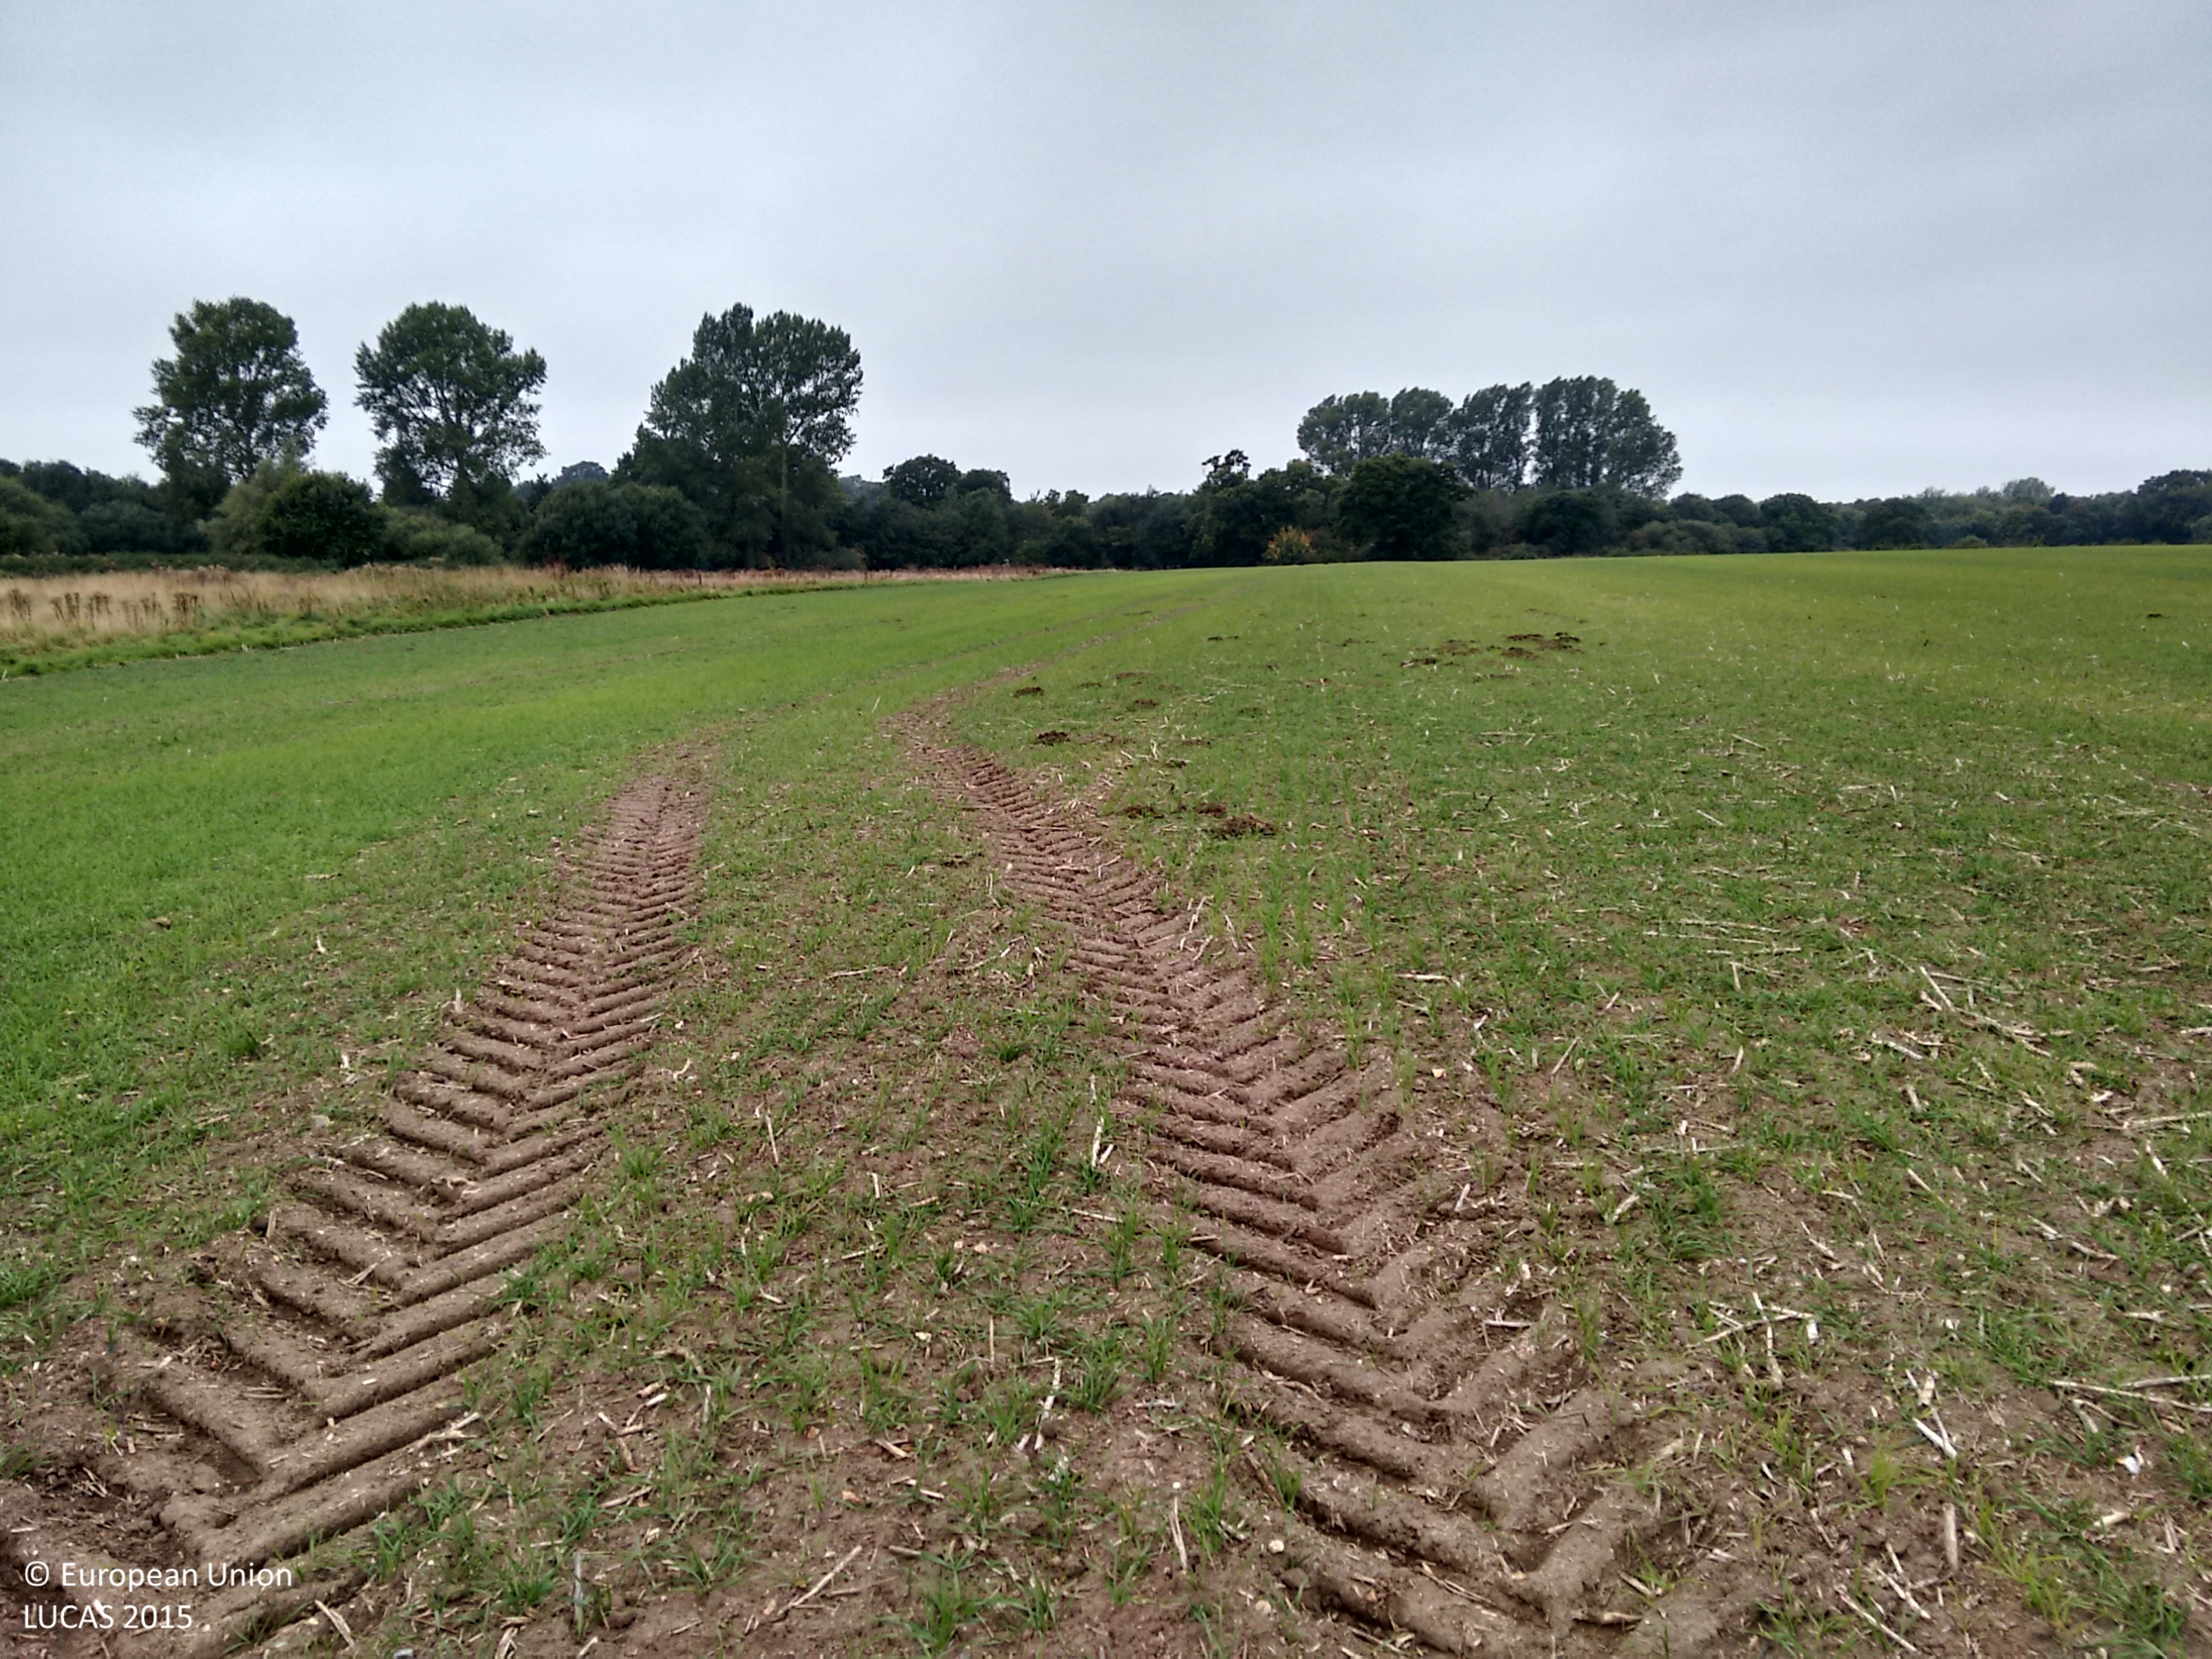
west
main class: Cropland
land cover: Common wheat
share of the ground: 25 - 50 %
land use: Agriculture (excluding fallow land and kitchen gardens)
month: October
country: GB
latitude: 52.4869
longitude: 1.4837
